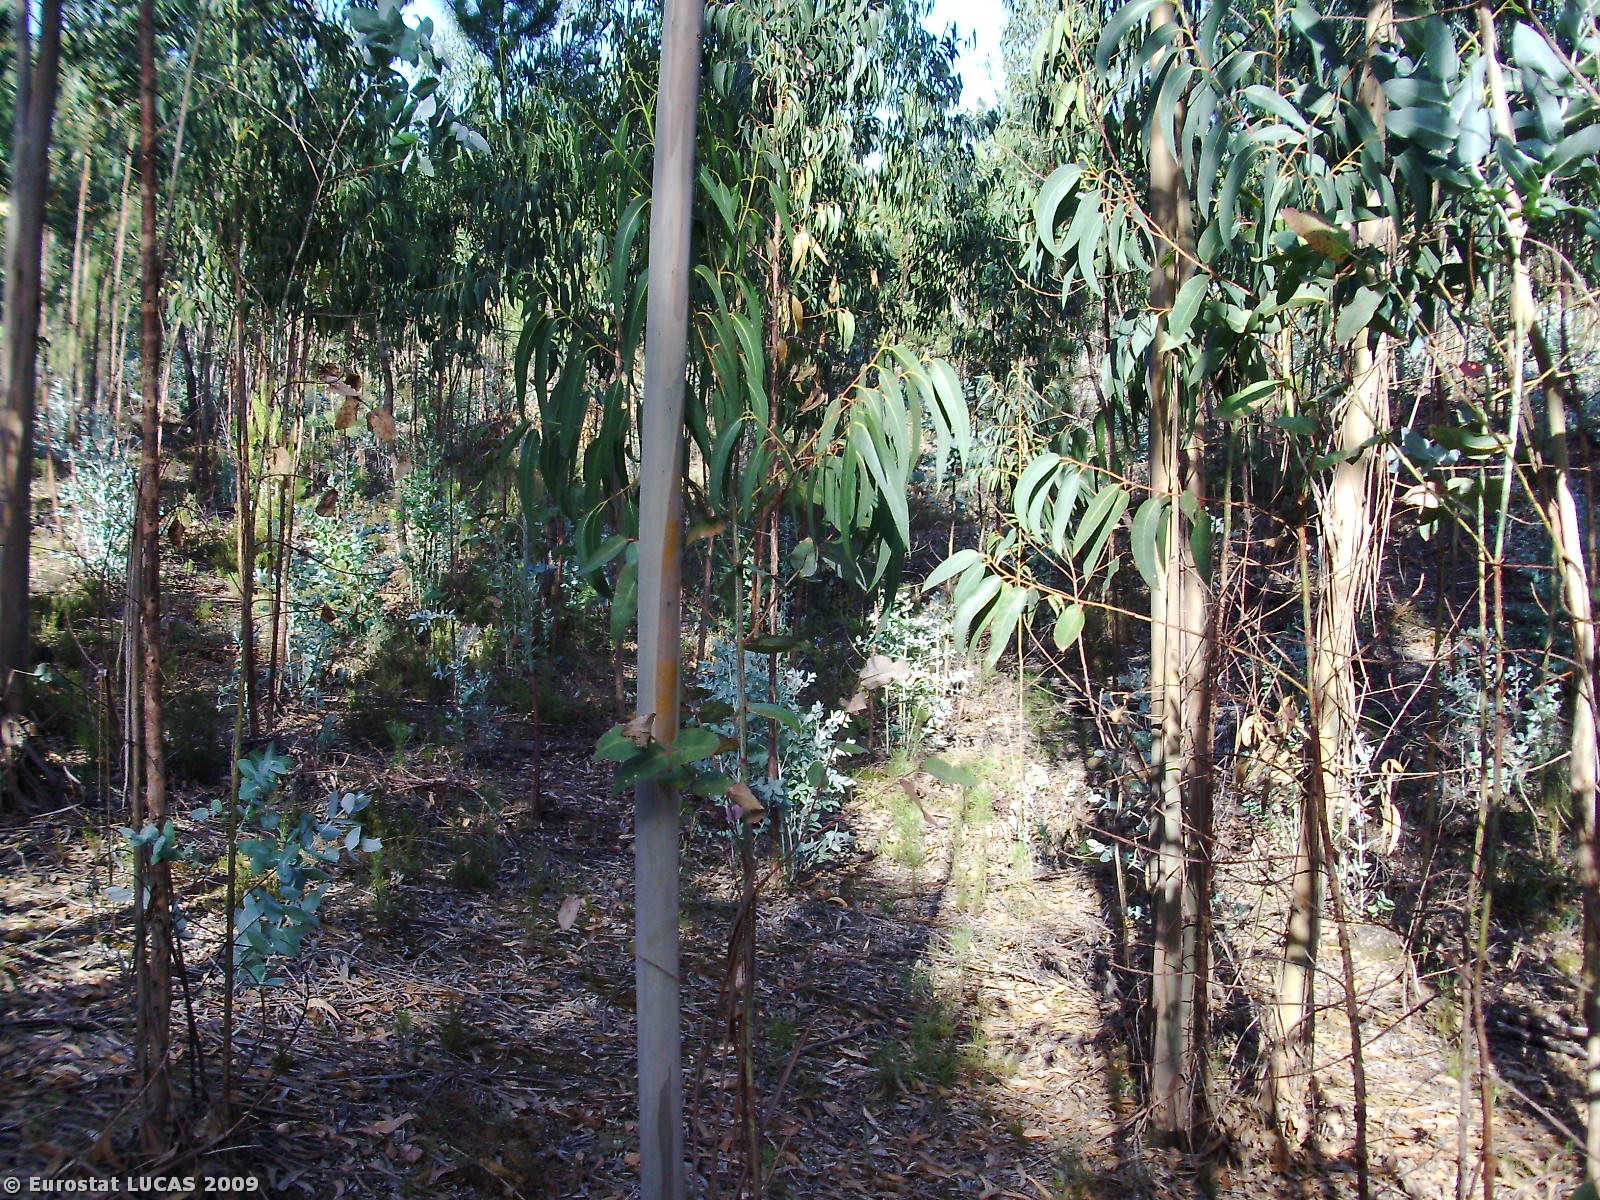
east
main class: Woodland
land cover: Broadleaved woodland
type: plantations and self-sown exotic forest
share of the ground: 50 - 75 %
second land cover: Bare land
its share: 25 - 50 %
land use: Forestry
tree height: > 5 m
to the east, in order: Broadleaved woodland; Bare land; Broadleaved woodland; Tracks; Broadleaved woodland; Shrubland with sparse tree cover; Tracks; Broadleaved woodland; Shrubland with sparse tree cover
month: July
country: PT
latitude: 39.3662
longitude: -8.8478
